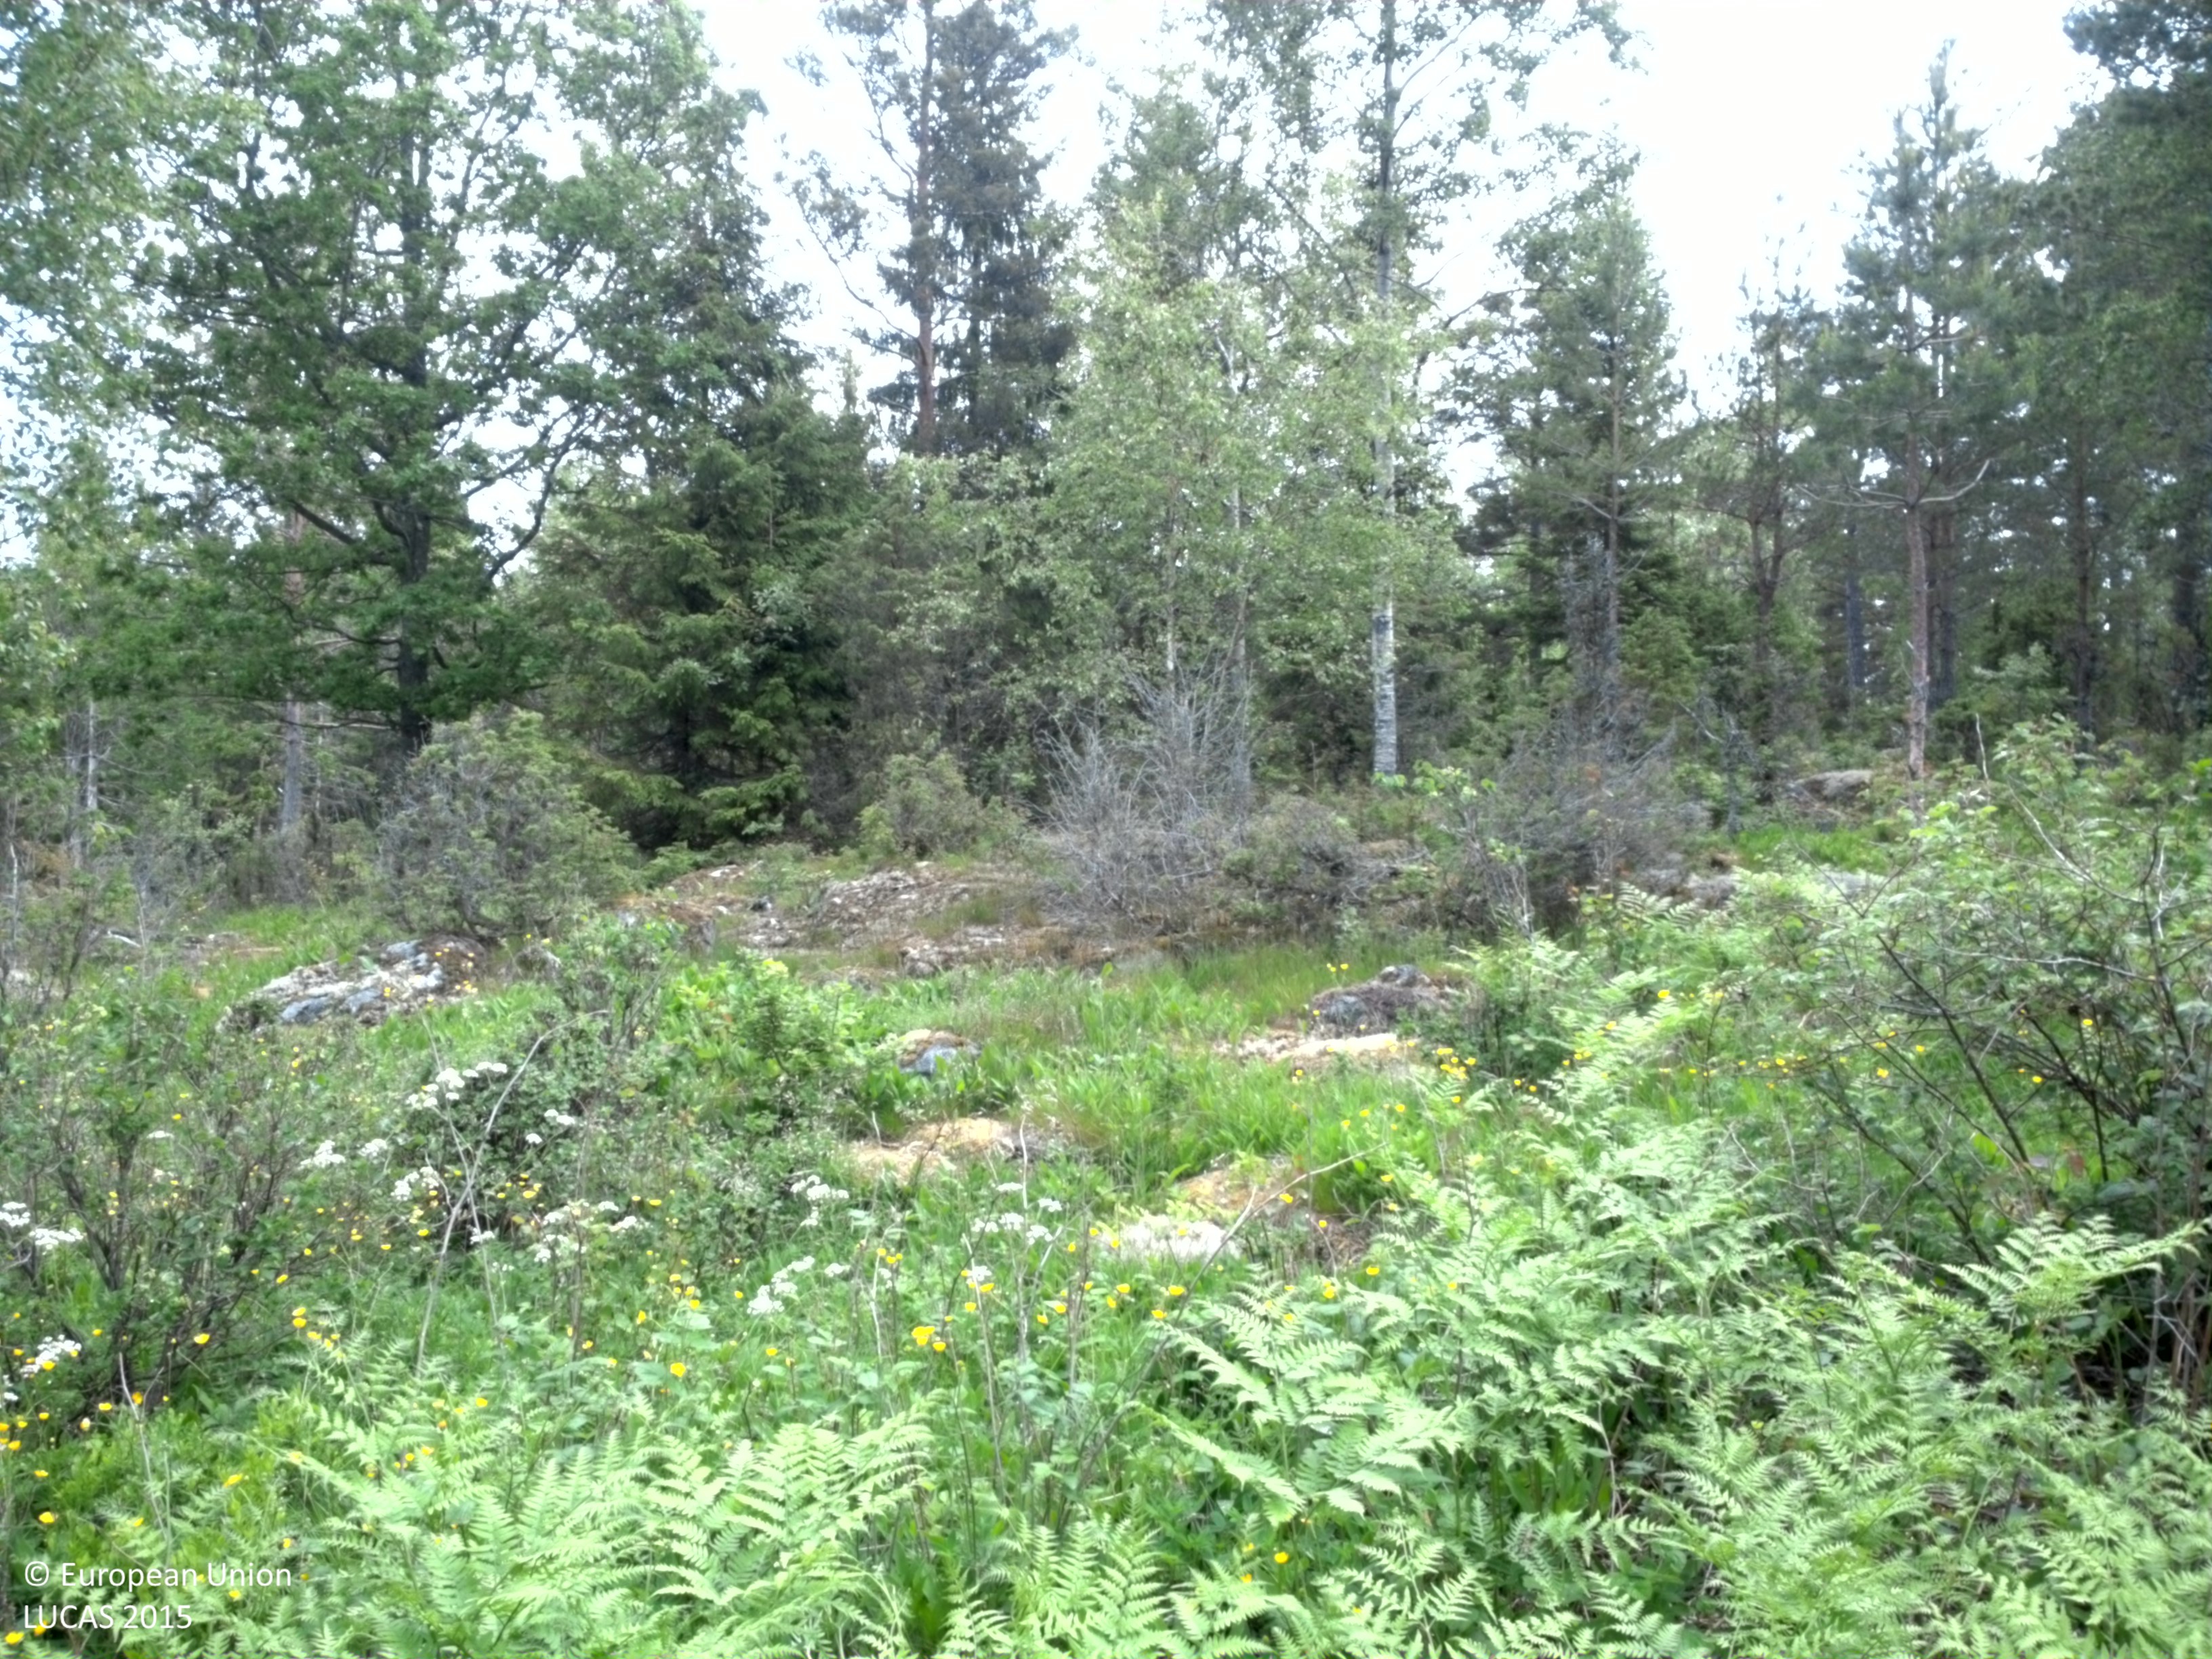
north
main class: Woodland
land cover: Broadleaved woodland
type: hemiboreal forest and nemoral coniferous forest and mixed broadleaved-coniferous forest
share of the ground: 10 - 25 %
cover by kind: herbaceous plants 50 %, broadleaved forest trees 20 %, lichens and mosses 15 %, shrubs 10 %, coniferous forest trees 5 %
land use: Forestry
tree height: > 5 m
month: June
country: SE
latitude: 60.0159
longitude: 18.7711
